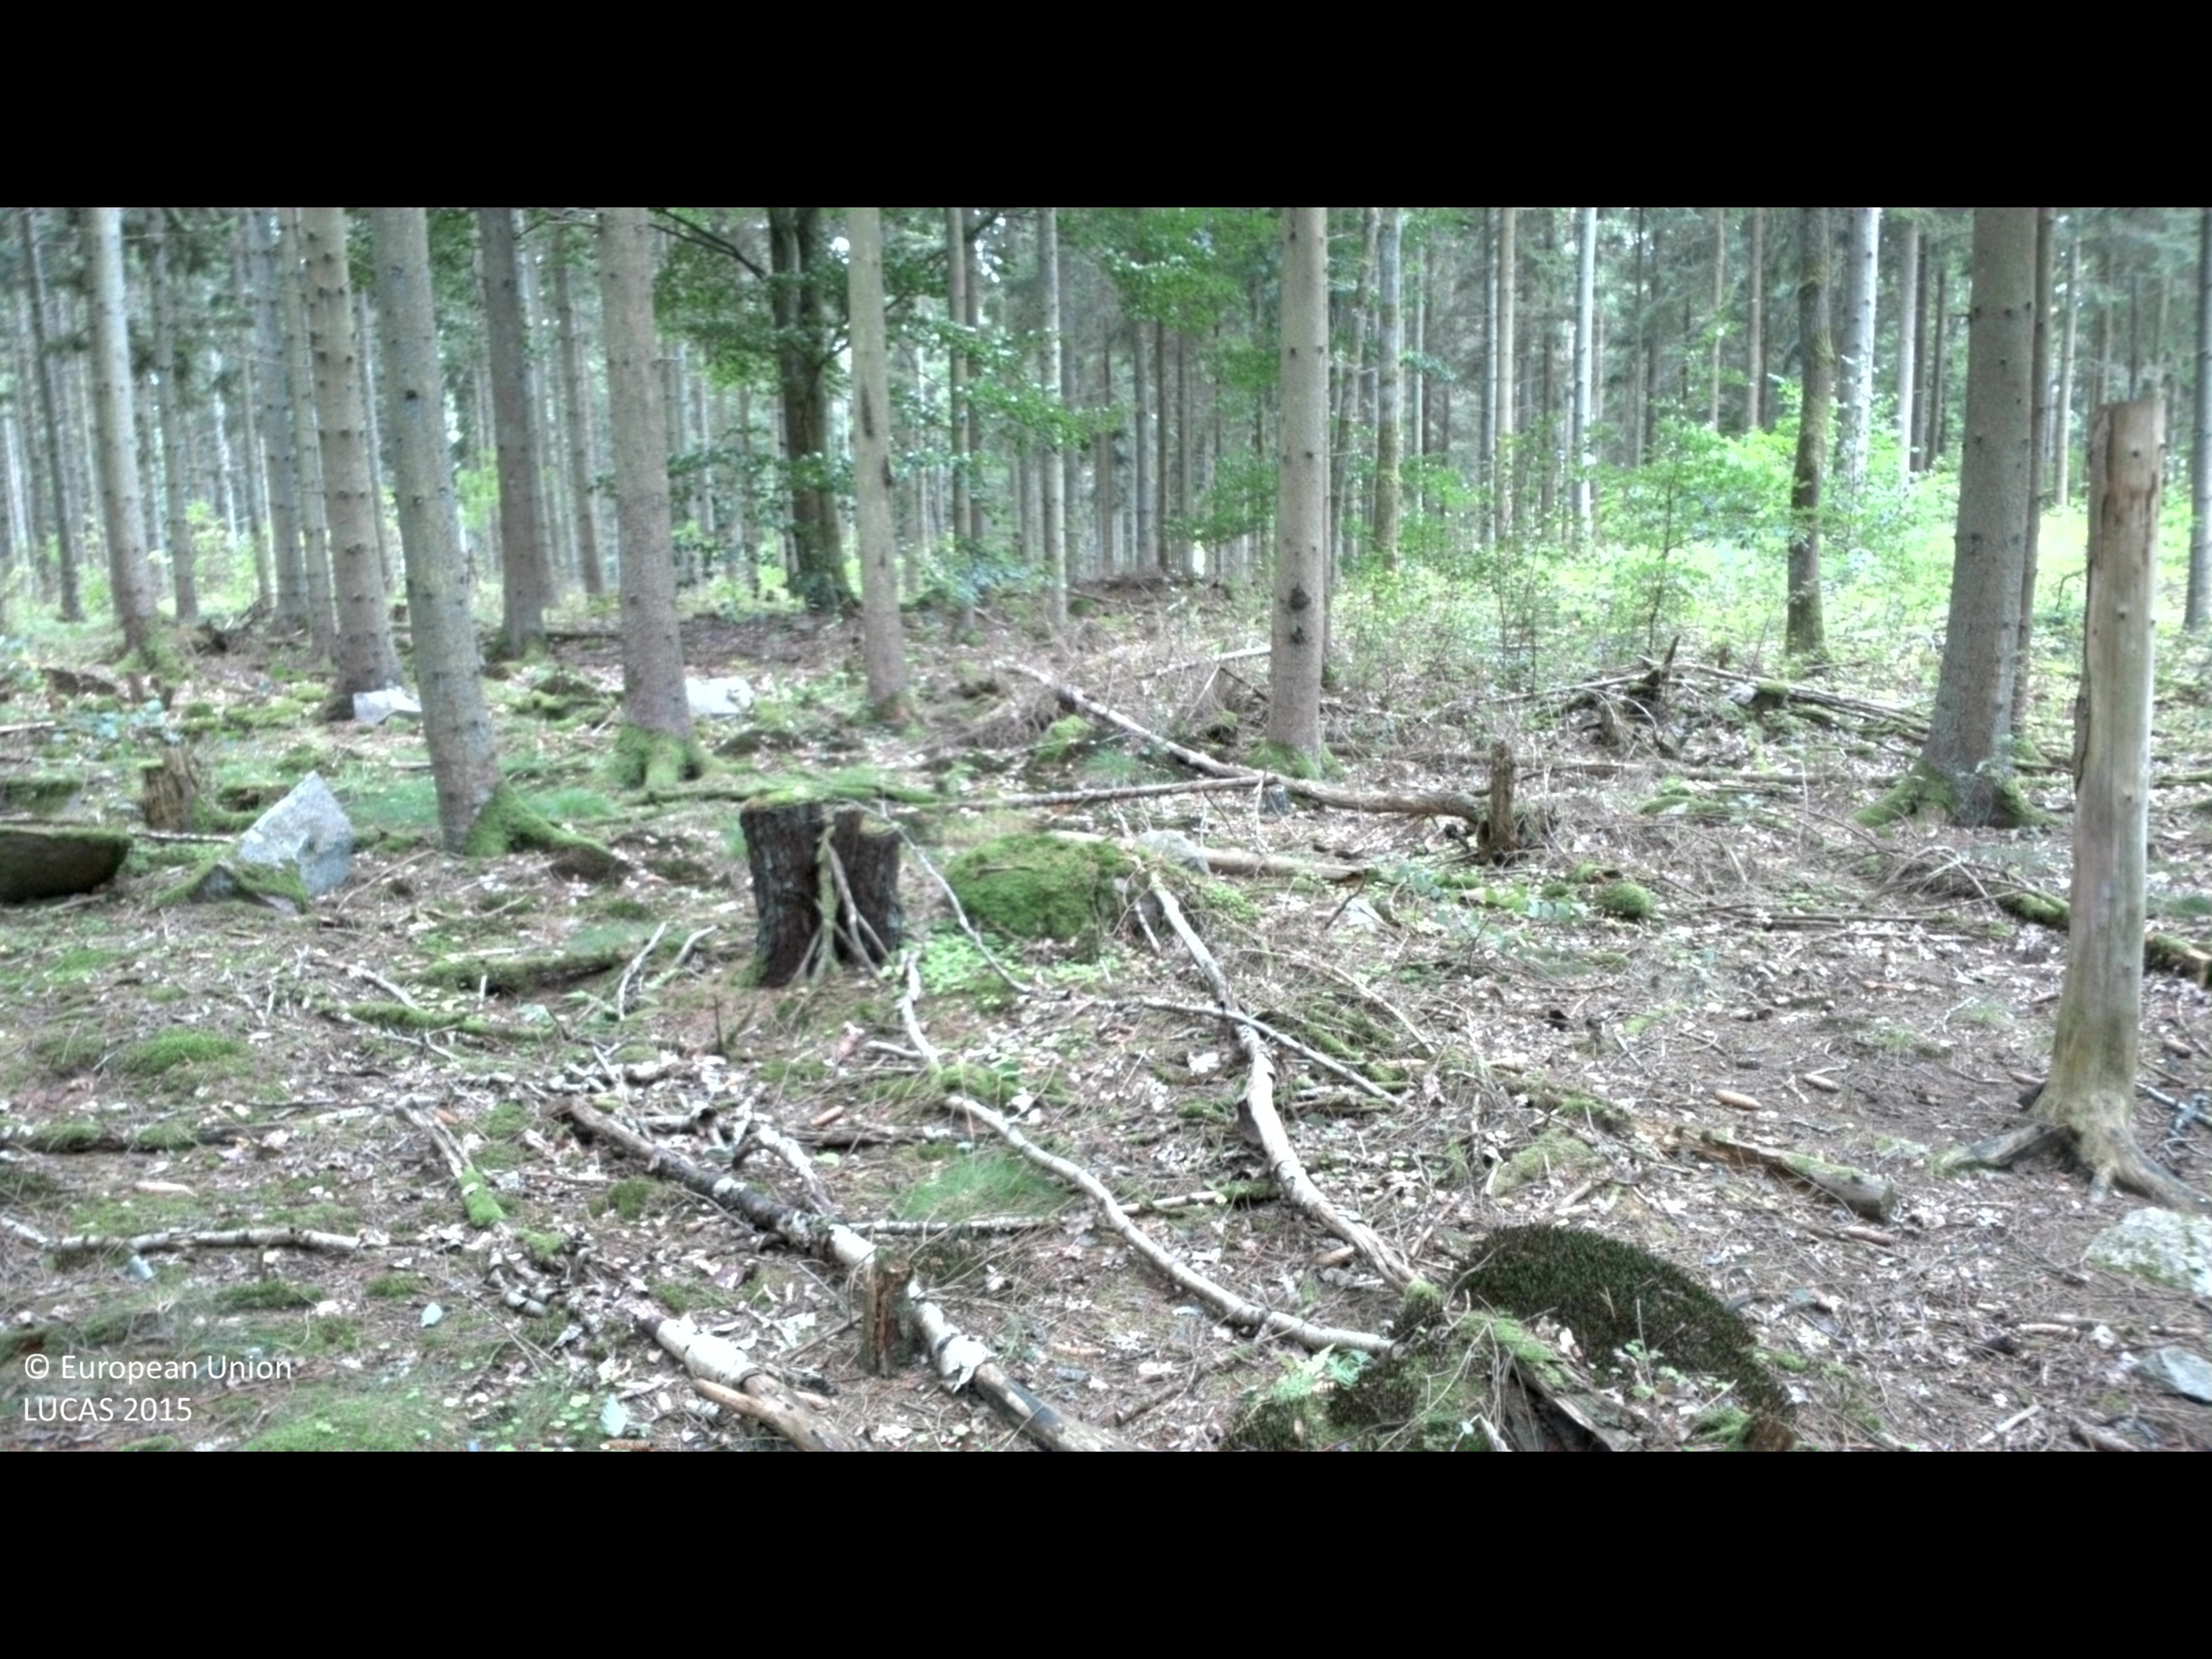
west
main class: Woodland
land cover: Spruce dominated coniferous woodland
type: boreal forest
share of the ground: > 75 %
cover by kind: coniferous forest trees 75 %, lichens and mosses 15 %, broadleaved forest trees 5 %, shrubs 5 %
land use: Forestry
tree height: > 5 m
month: September
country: SE
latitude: 56.1223
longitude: 14.0996
